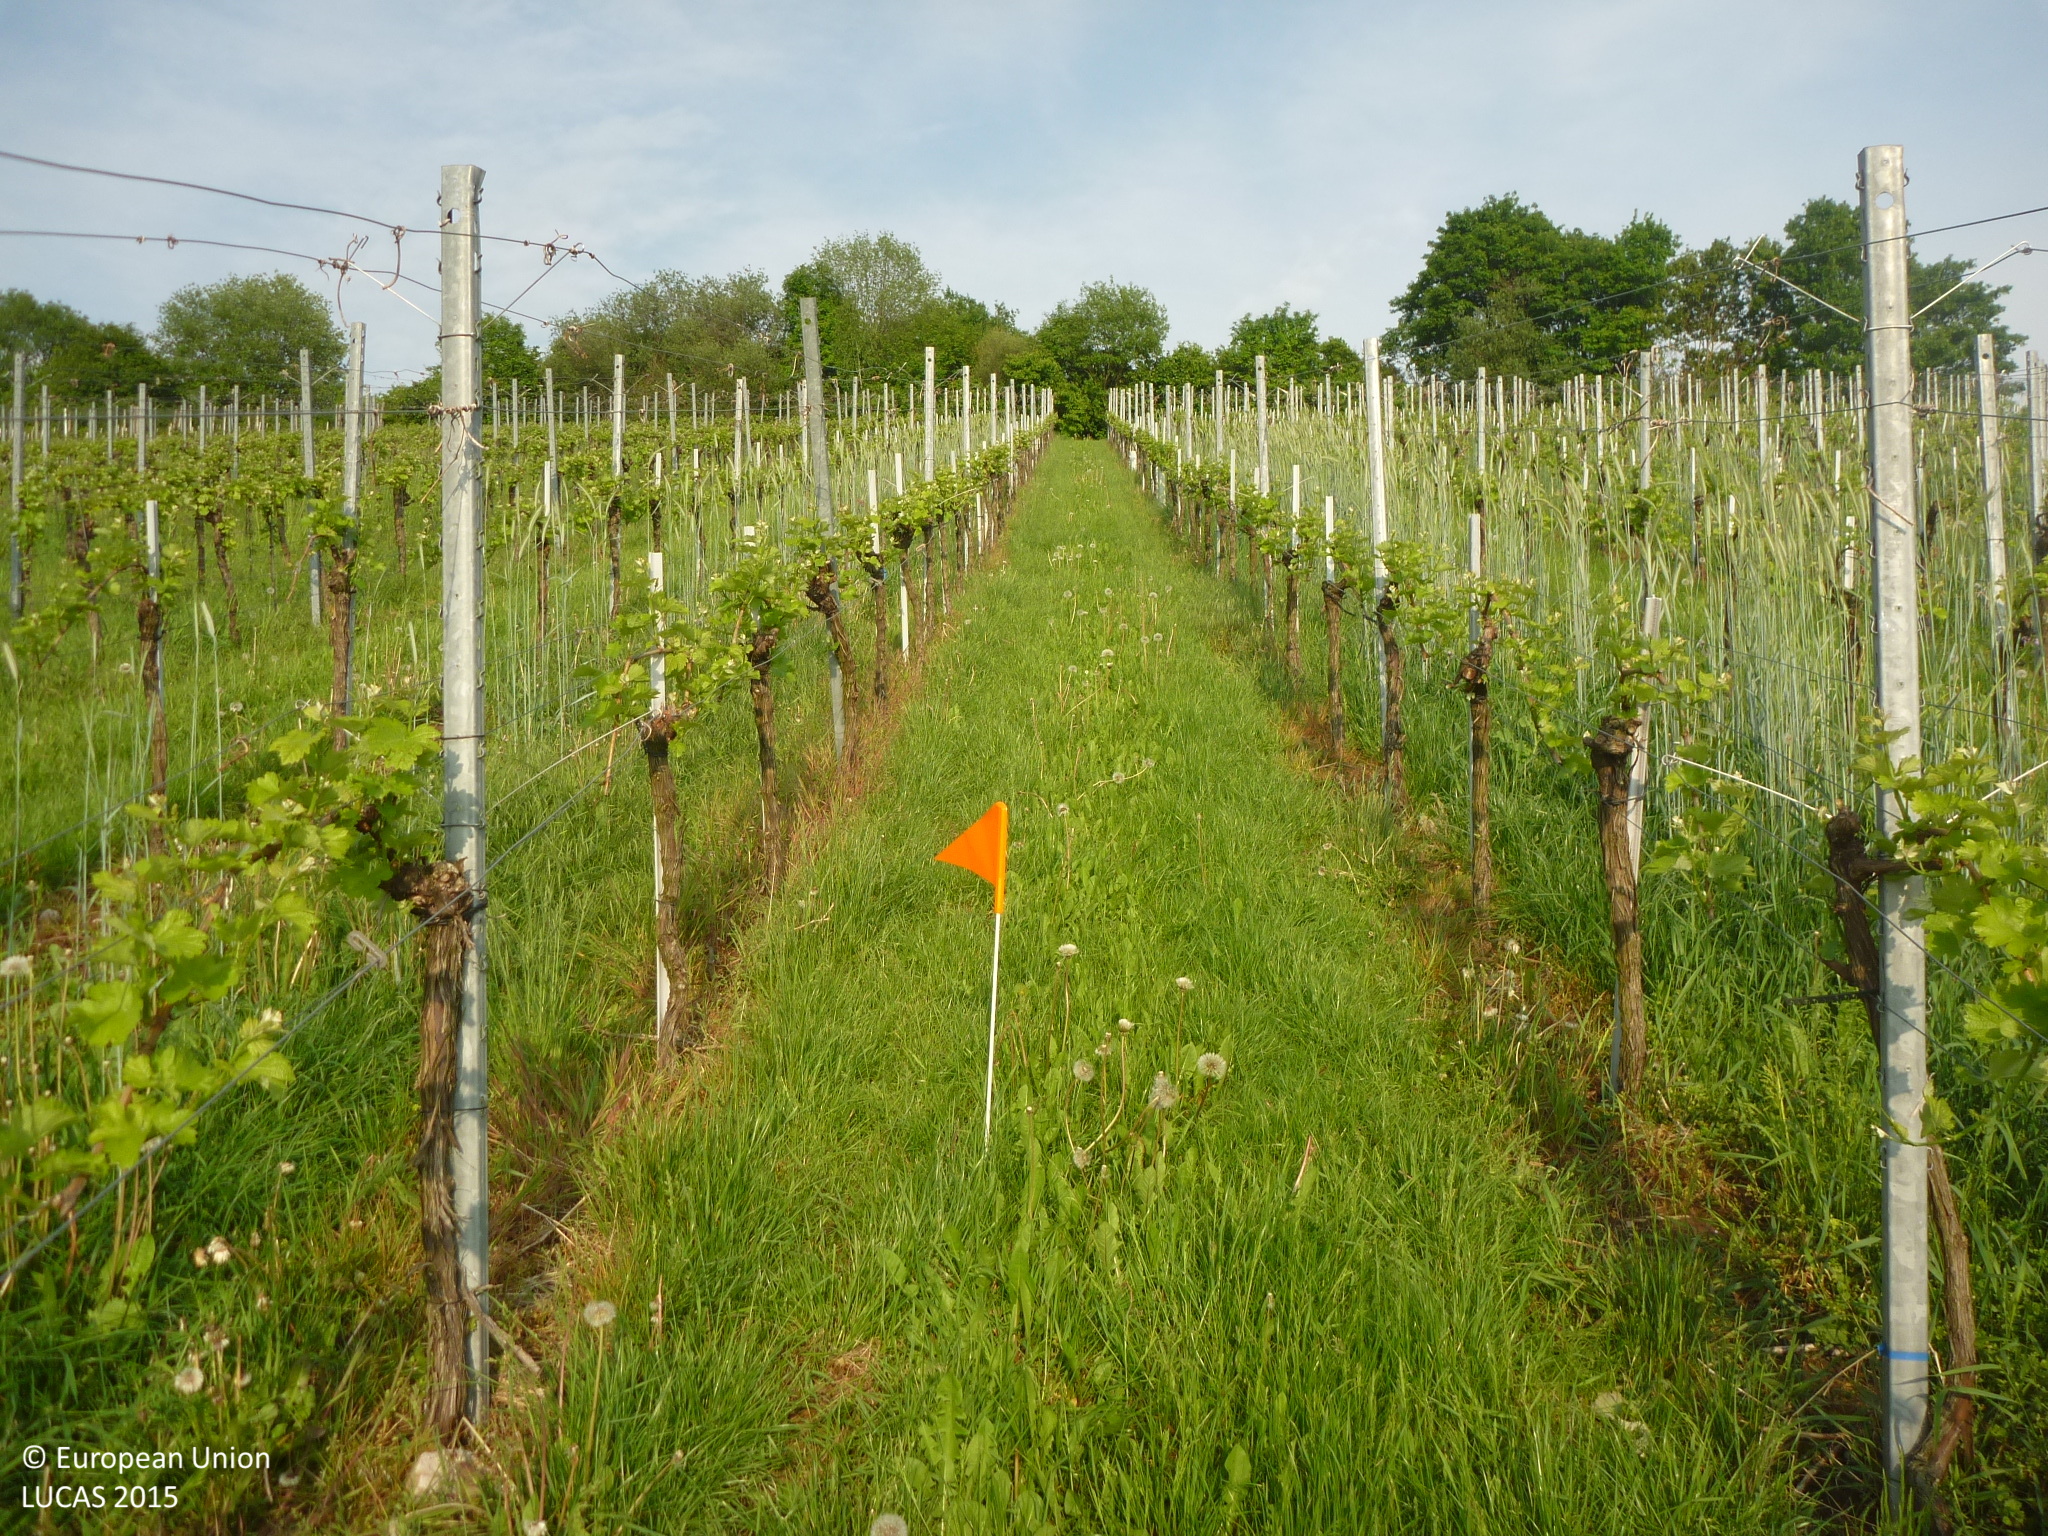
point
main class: Cropland
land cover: Vineyards
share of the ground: 10 - 25 %
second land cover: Grassland without tree/shrub cover
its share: > 75 %
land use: Agriculture (excluding fallow land and kitchen gardens)
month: May
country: DE
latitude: 48.7978
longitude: 9.4149
